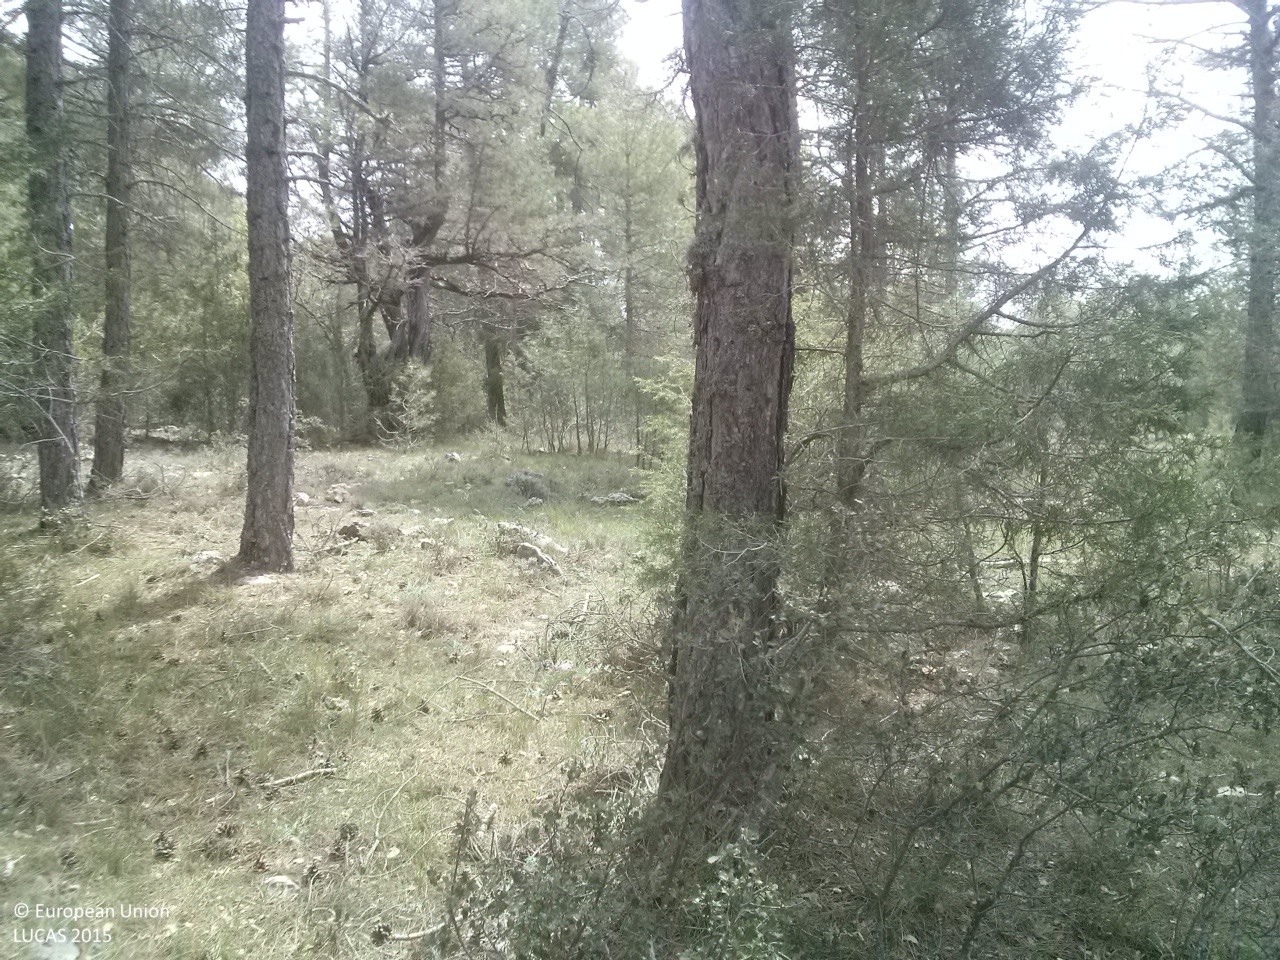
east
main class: Woodland
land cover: Pine dominated mixed woodland
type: coniferous forest of the mediterranean region
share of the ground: 50 - 75 %
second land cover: Shrubland without tree cover
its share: 10 - 25 %
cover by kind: coniferous forest trees 55 %, broadleaved forest trees 20 %, shrubs 15 %, herbaceous plants 10 %
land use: Forestry
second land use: Agriculture (excluding fallow land and kitchen gardens)
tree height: > 5 m
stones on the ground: > 50 %
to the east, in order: Pine dominated mixed woodland; Shrubland without tree cover; Pine dominated mixed woodland
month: April
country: ES
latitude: 40.0297
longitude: -1.9311
